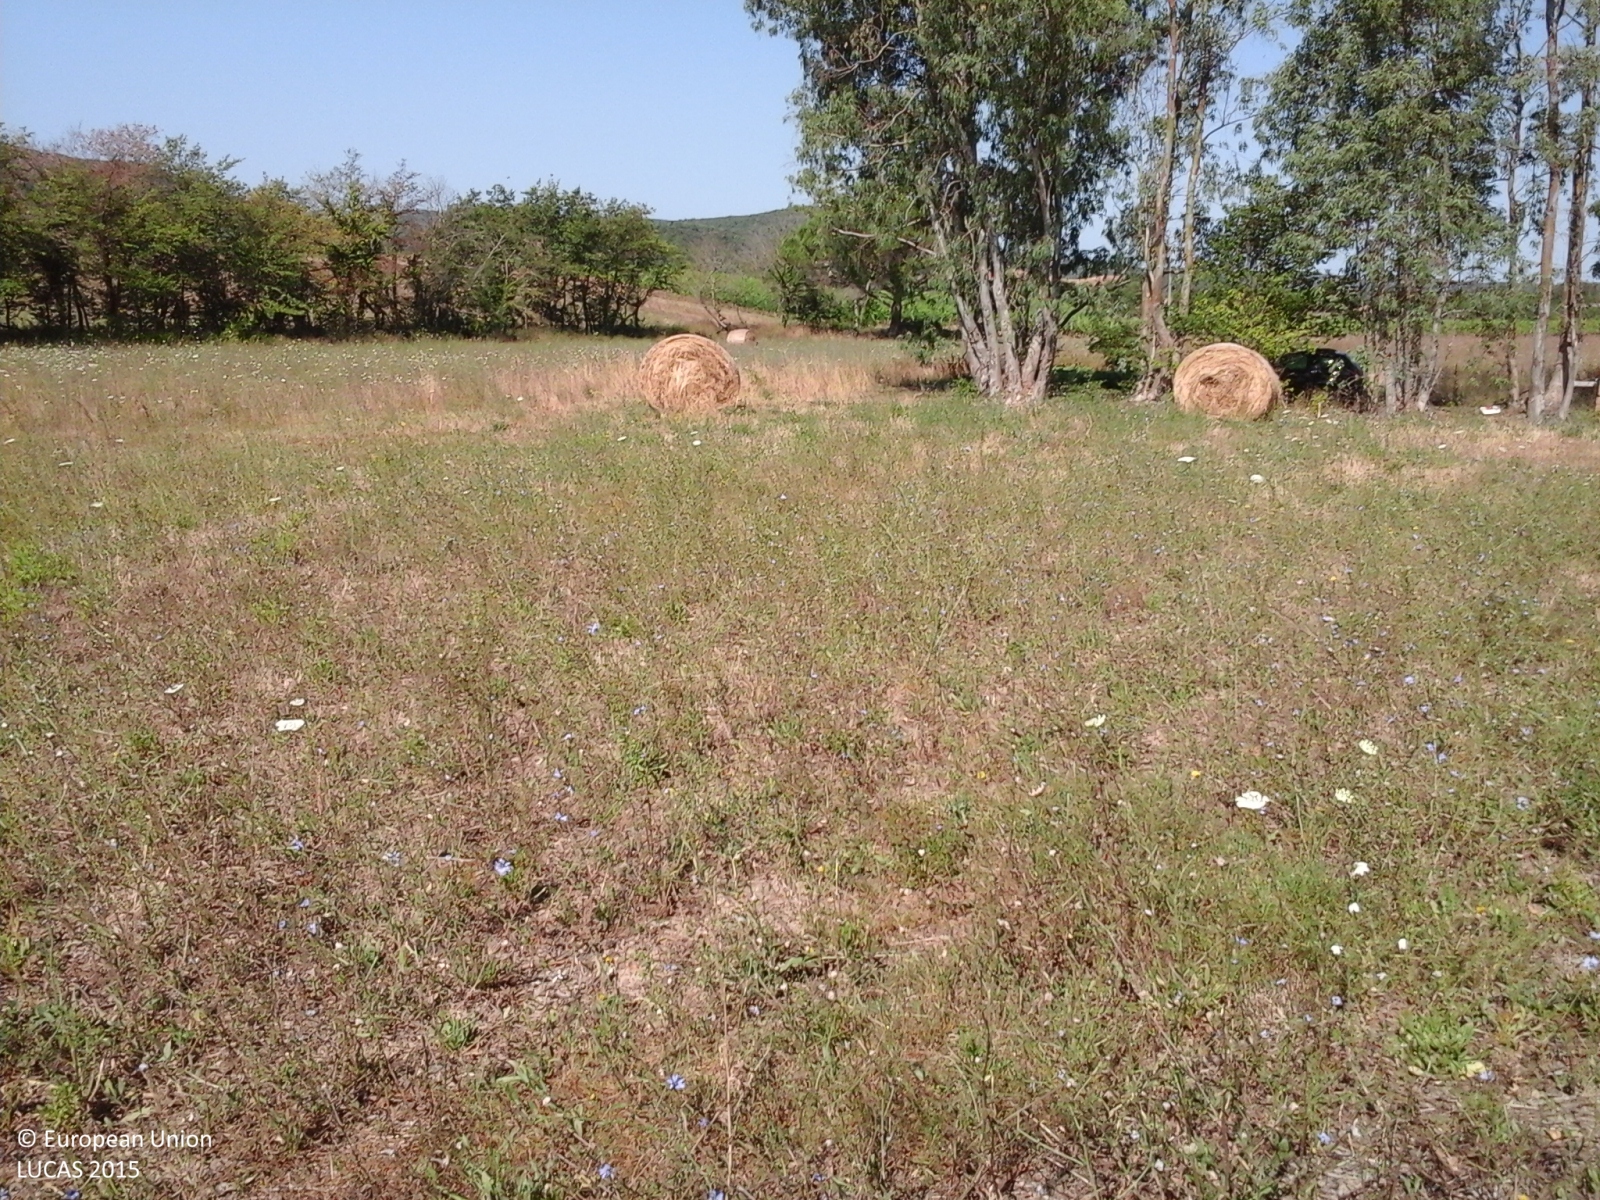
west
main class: Grassland
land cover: Spontaneously vegetated surfaces
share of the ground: > 75 %
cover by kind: herbaceous plants 100 %
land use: Agriculture (excluding fallow land and kitchen gardens)
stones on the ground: < 10 %
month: July
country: IT
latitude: 42.9747
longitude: 10.9412
